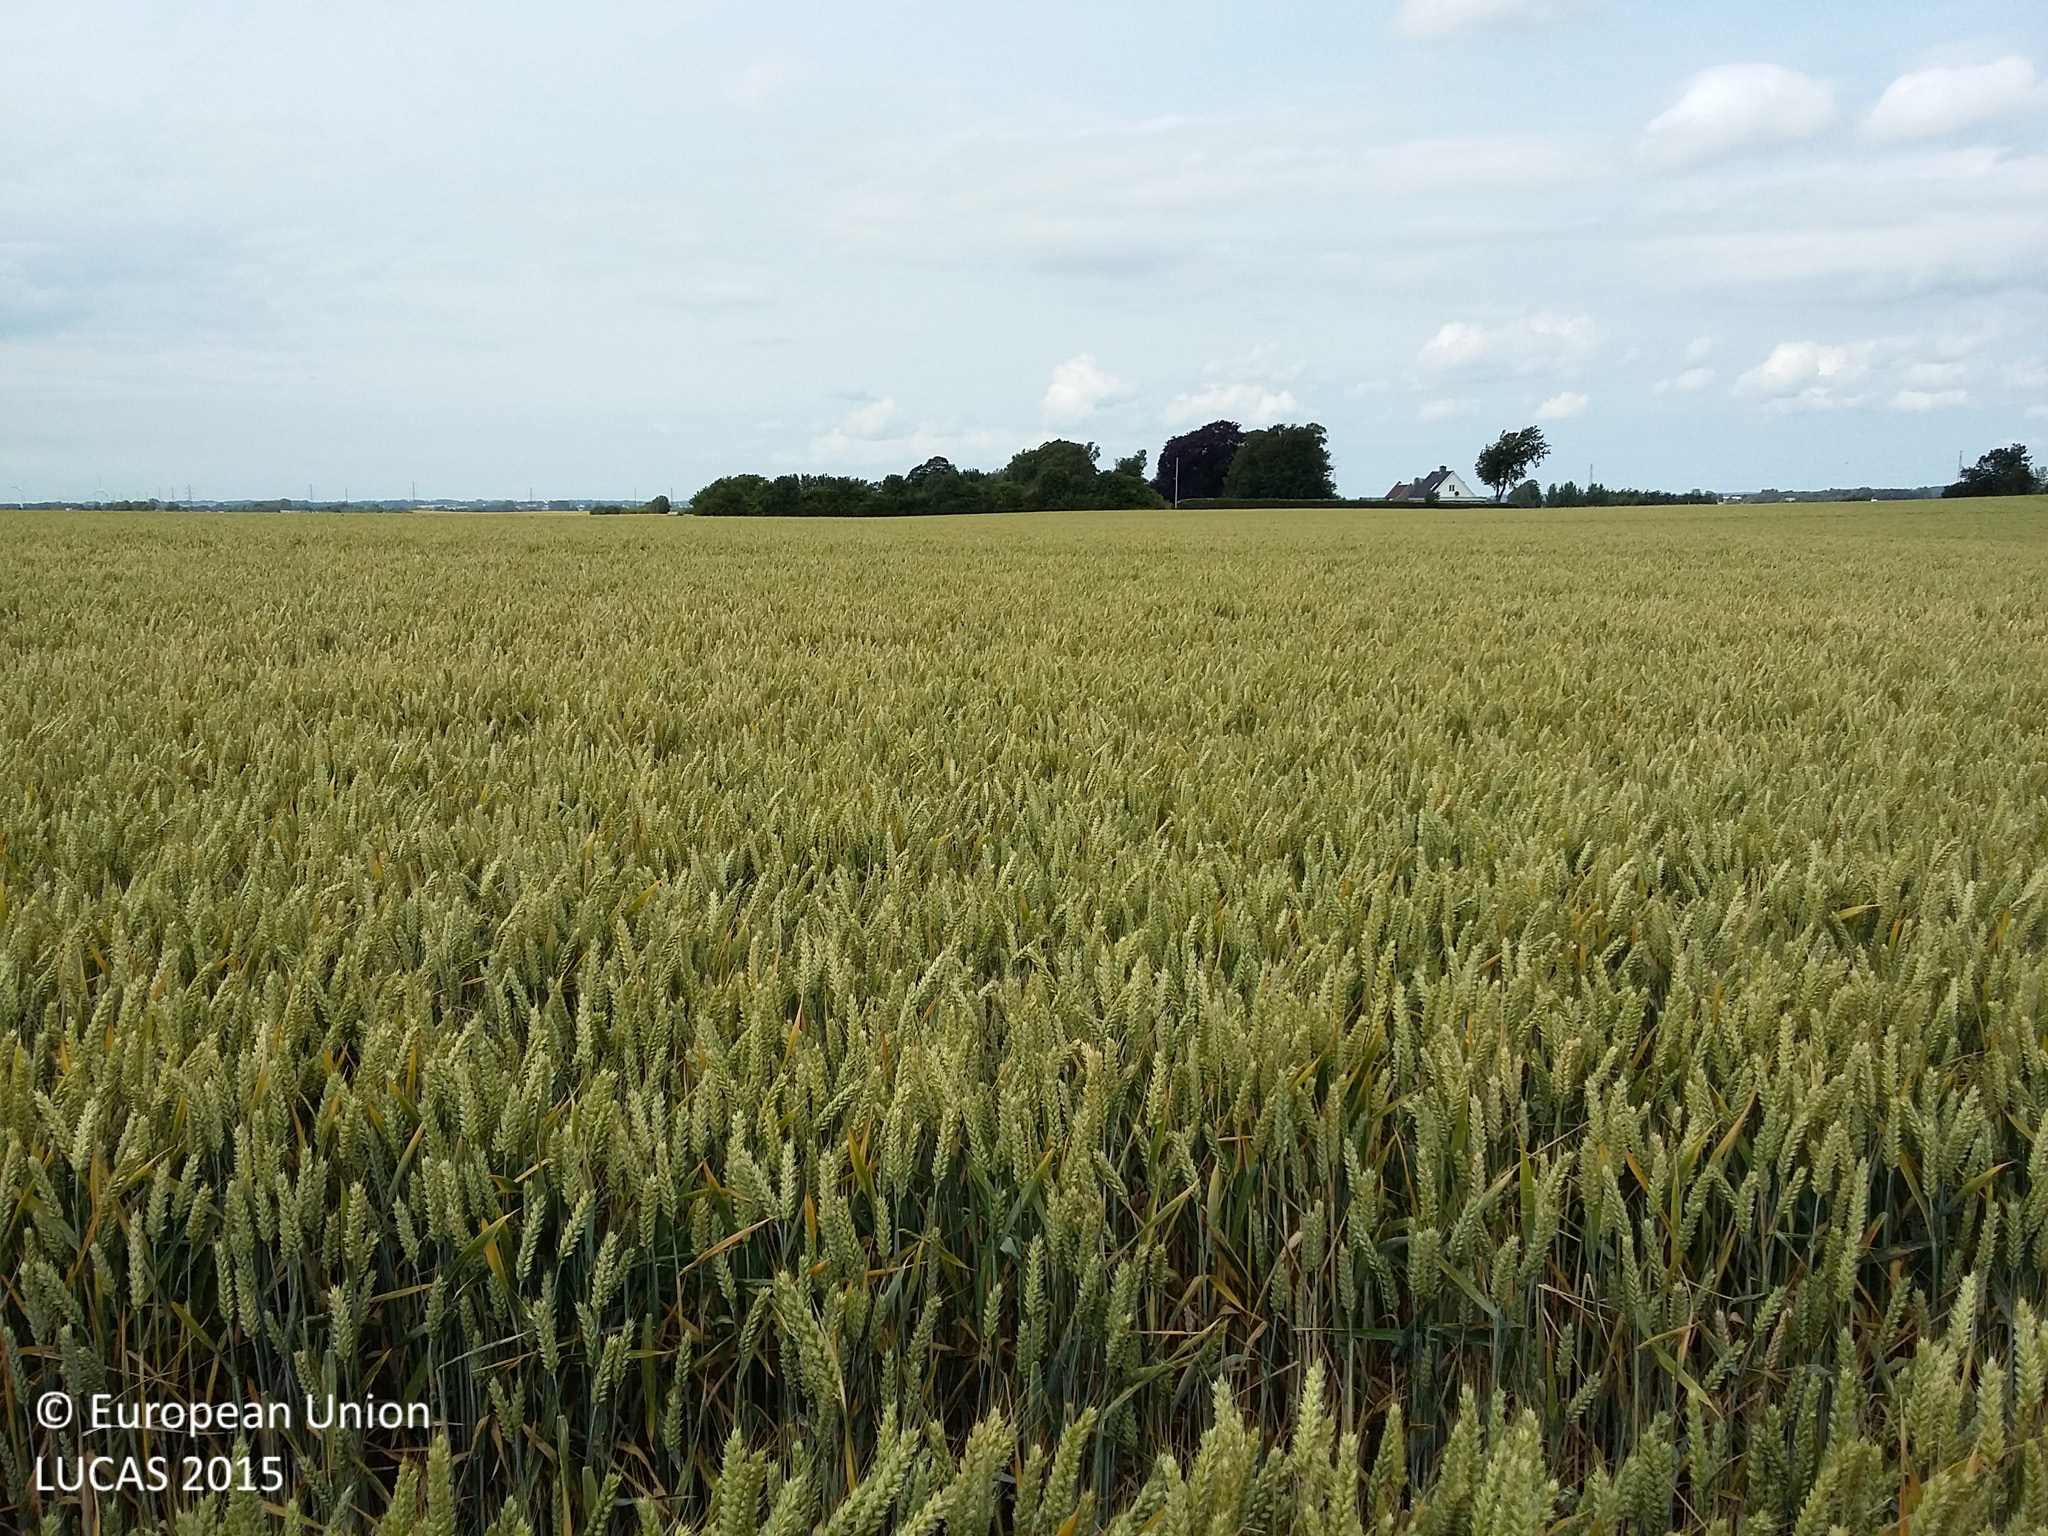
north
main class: Cropland
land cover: Common wheat
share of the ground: > 75 %
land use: Agriculture (excluding fallow land and kitchen gardens)
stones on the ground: < 10 %
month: July
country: DK
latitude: 55.5162
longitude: 11.2816
